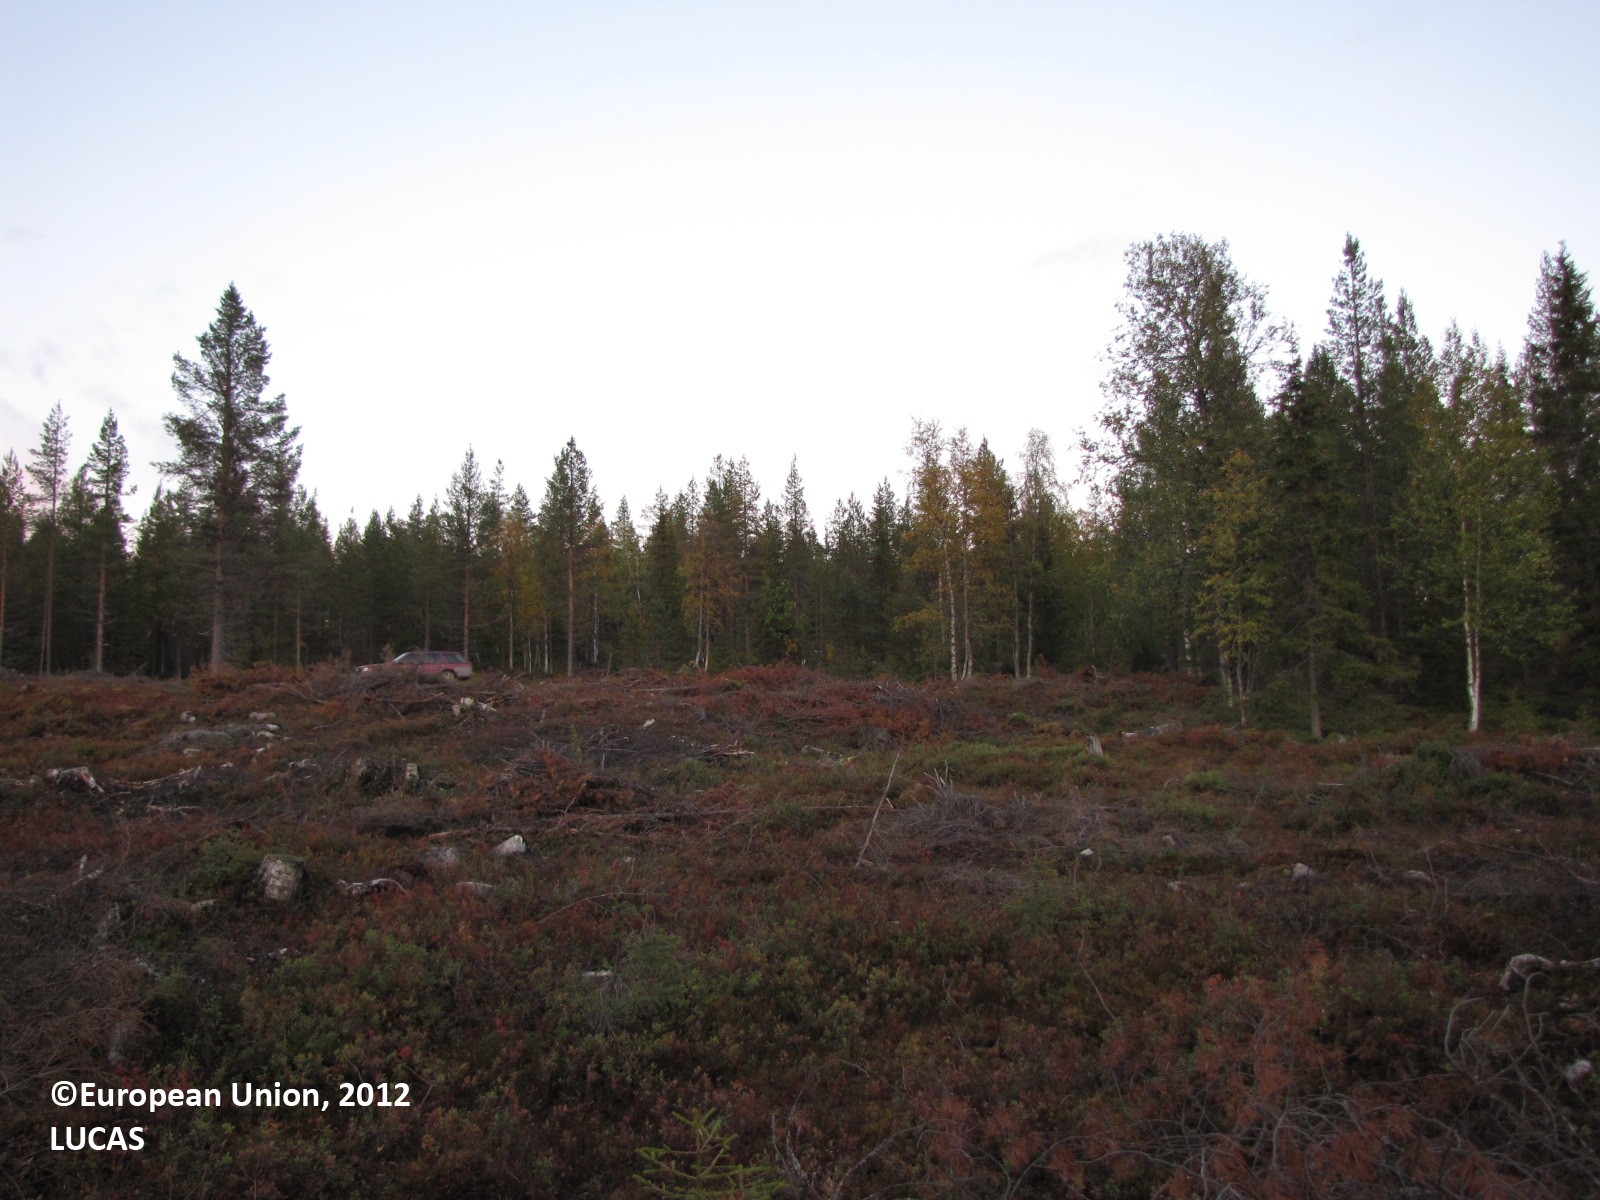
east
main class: Shrubland
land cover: Shrubland without tree cover
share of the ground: 10 - 25 %
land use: Forestry
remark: Clear cut
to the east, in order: Shrubland without tree cover; Paved roads, cycling and walking lanes; Ditches and canals; Tracks; Pine dominated mixed woodland; Tracks; Pine dominated mixed woodland; Tracks; Pine dominated mixed woodland; Tracks; Pine dominated coniferous woodland
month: September
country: FI
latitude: 67.3745
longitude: 25.2567
